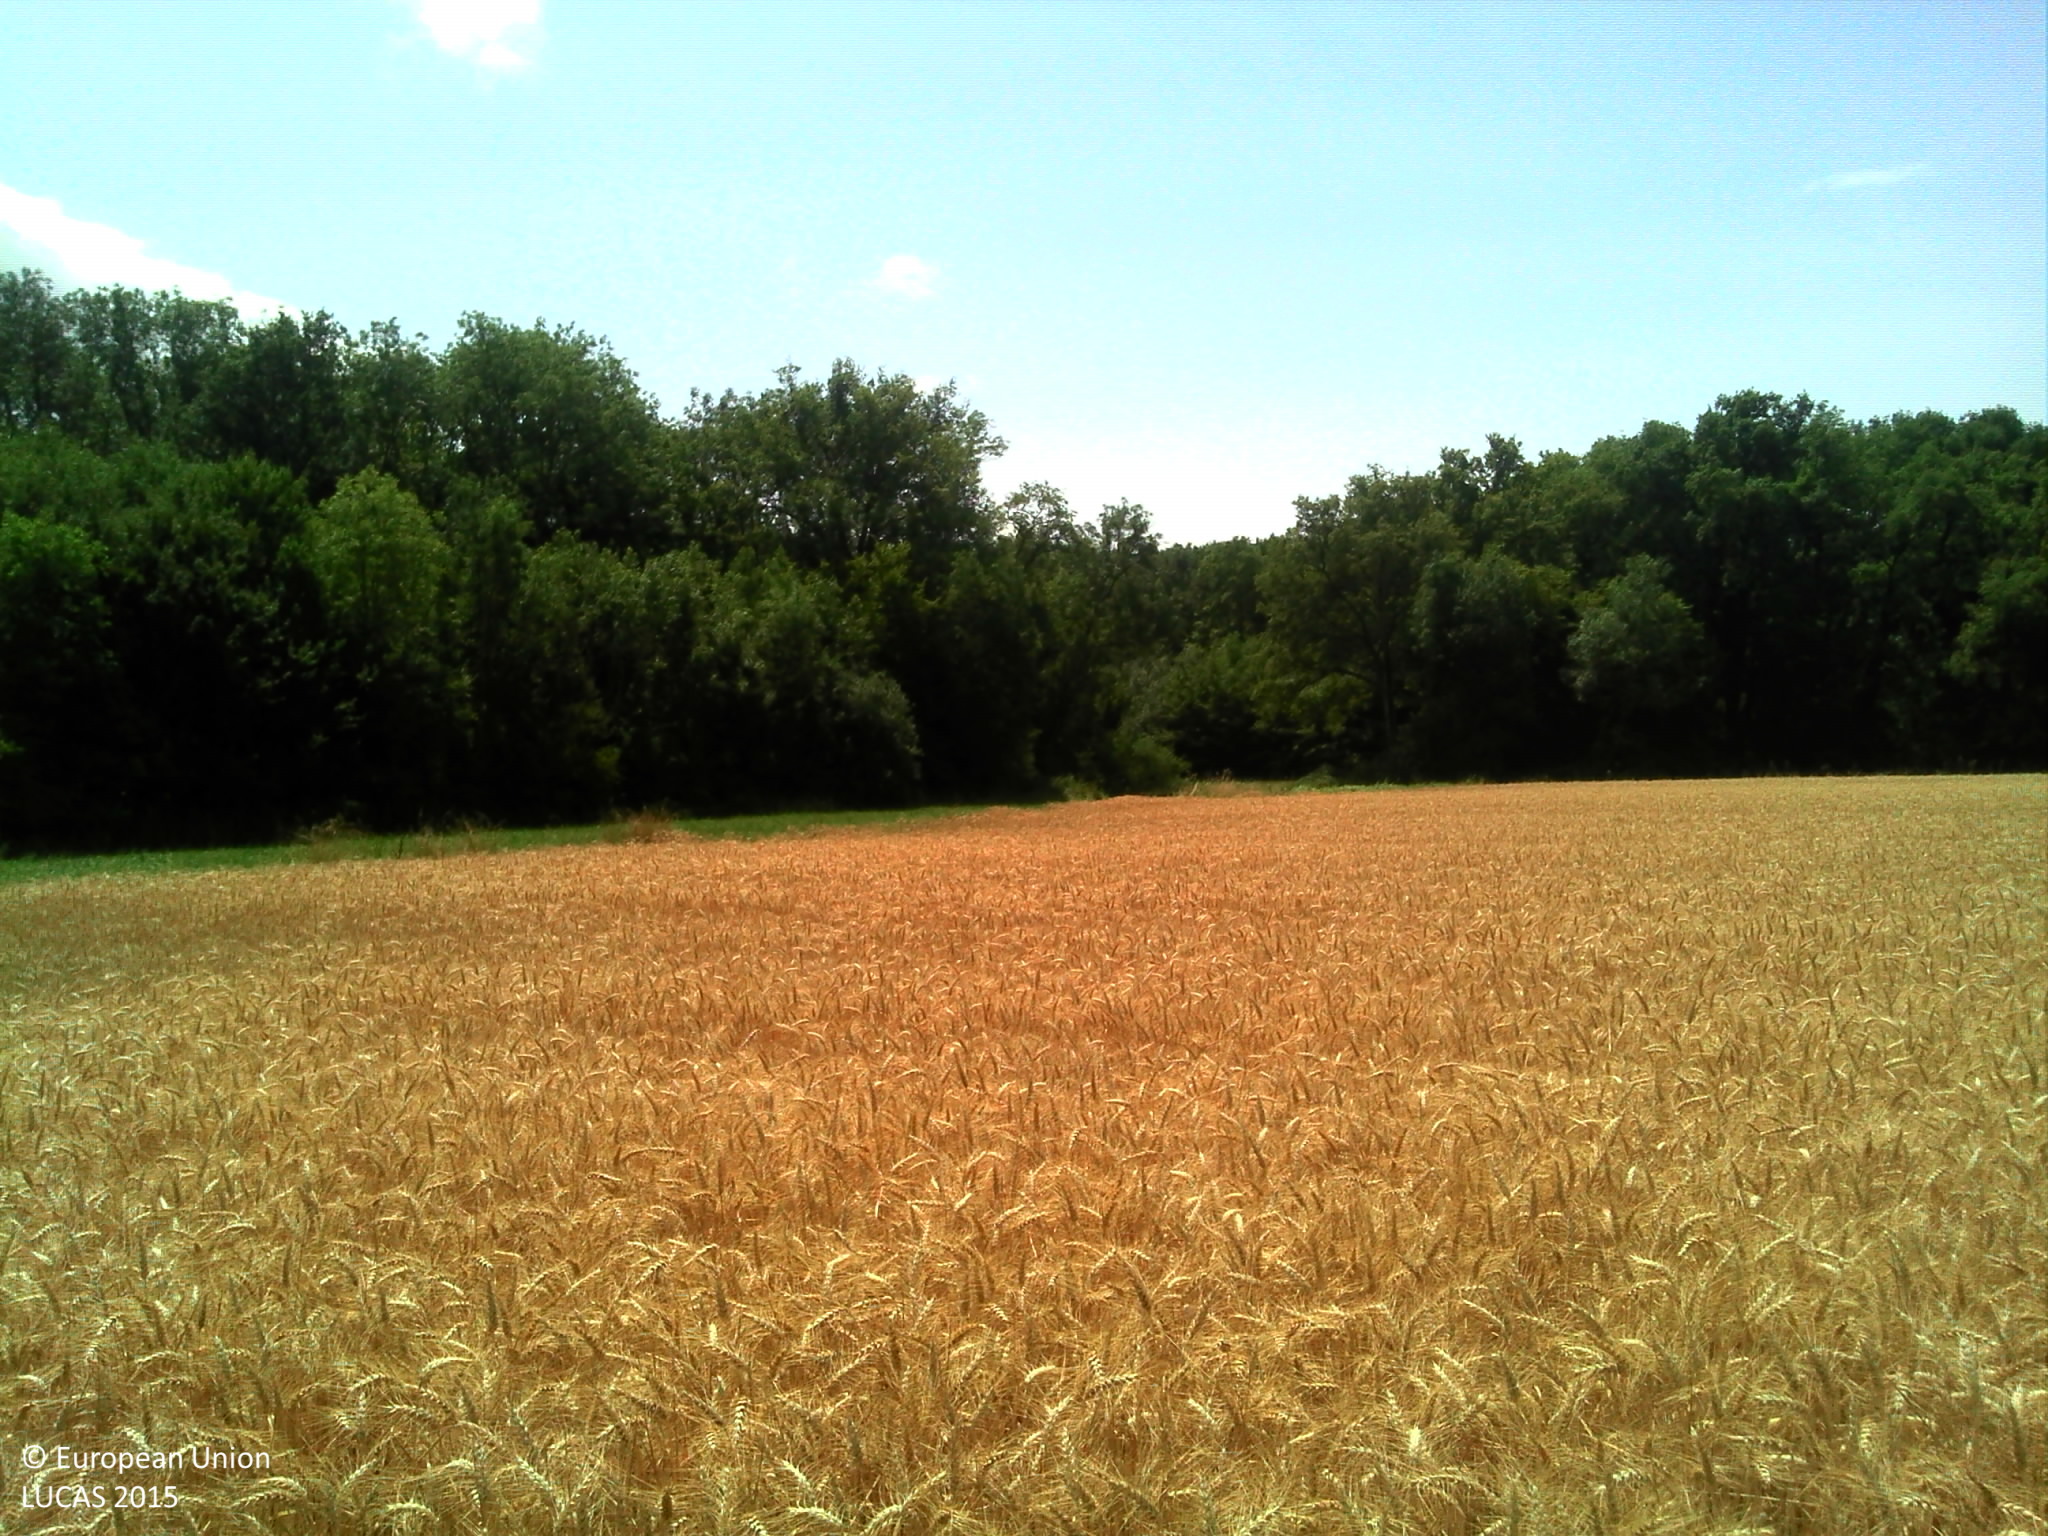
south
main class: Cropland
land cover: Durum wheat
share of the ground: > 75 %
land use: Agriculture (excluding fallow land and kitchen gardens)
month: July
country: FR
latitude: 46.3225
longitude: 6.2757
